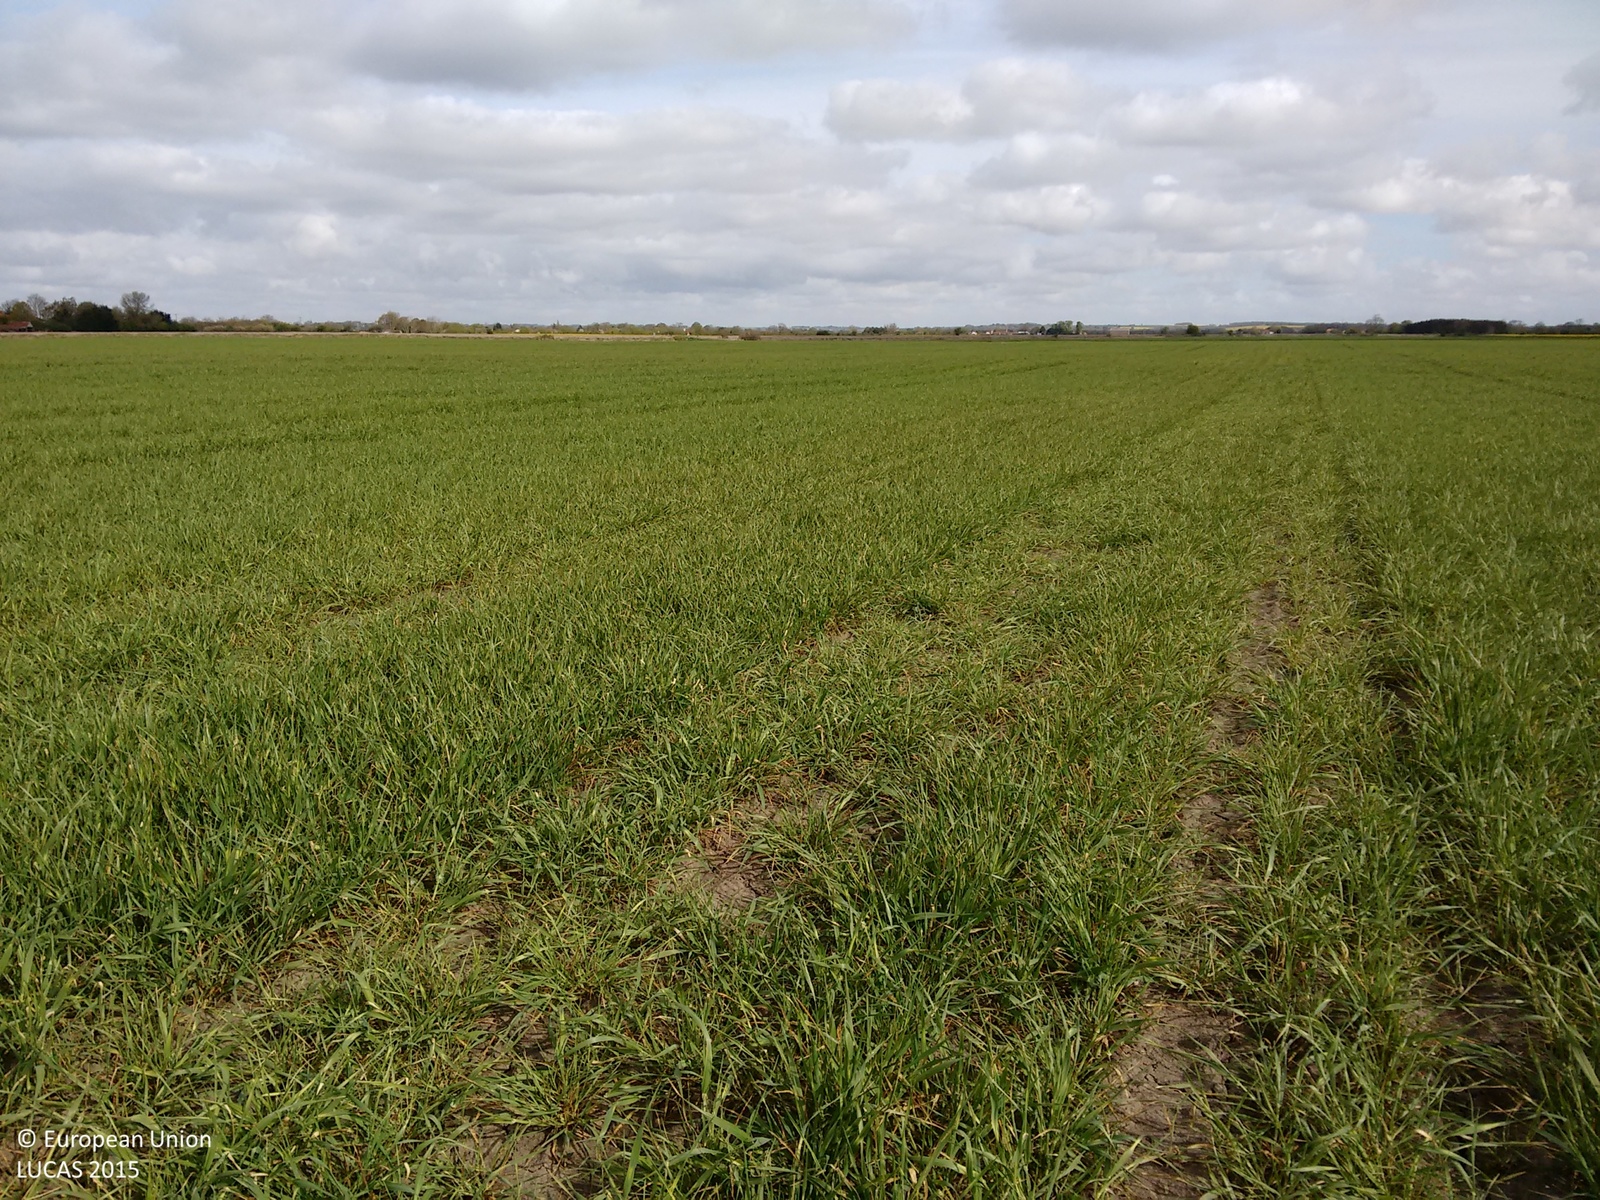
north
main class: Cropland
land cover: Barley
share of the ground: 50 - 75 %
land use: Agriculture (excluding fallow land and kitchen gardens)
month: May
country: GB
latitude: 53.1264
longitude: 0.1511
